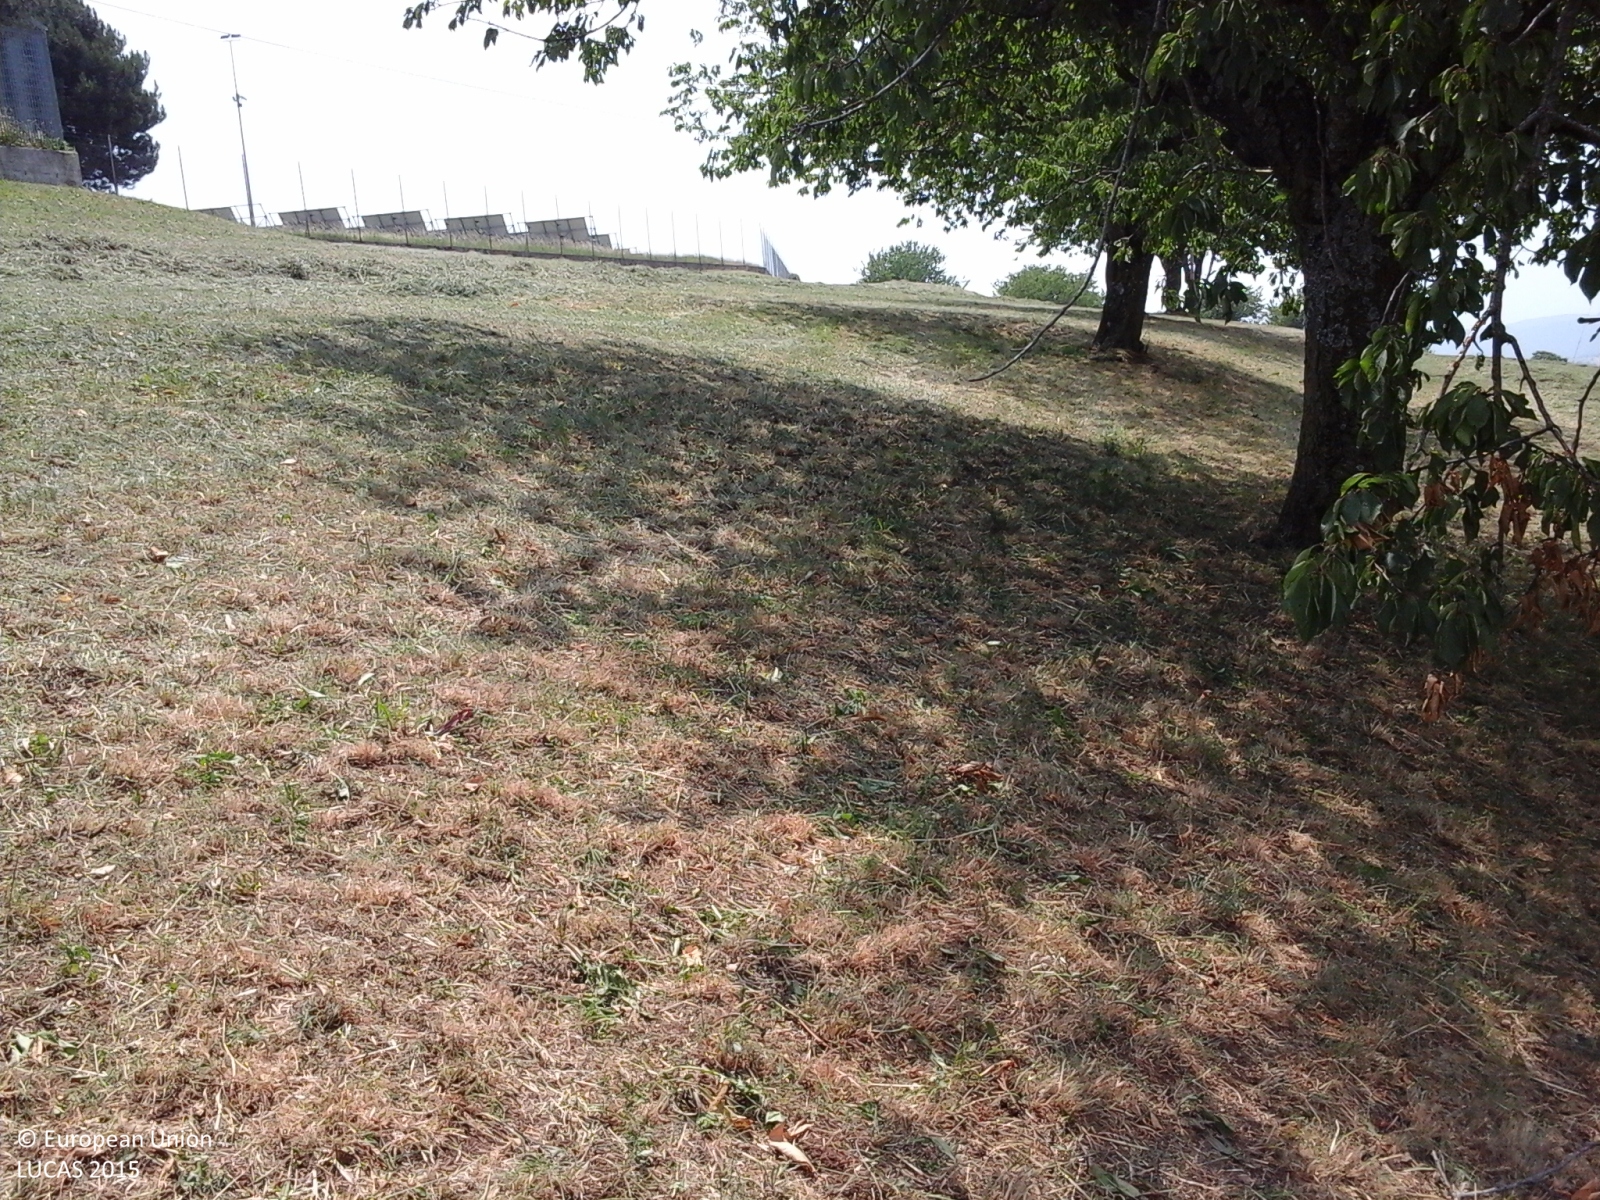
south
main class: Grassland
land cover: Grassland with sparse tree/shrub cover
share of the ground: > 75 %
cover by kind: herbaceous plants 85 %, shrubs 10 %, broadleaved forest trees 5 %
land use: Agriculture (excluding fallow land and kitchen gardens)
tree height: > 5 m
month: July
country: IT
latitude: 45.5894
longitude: 11.0366
